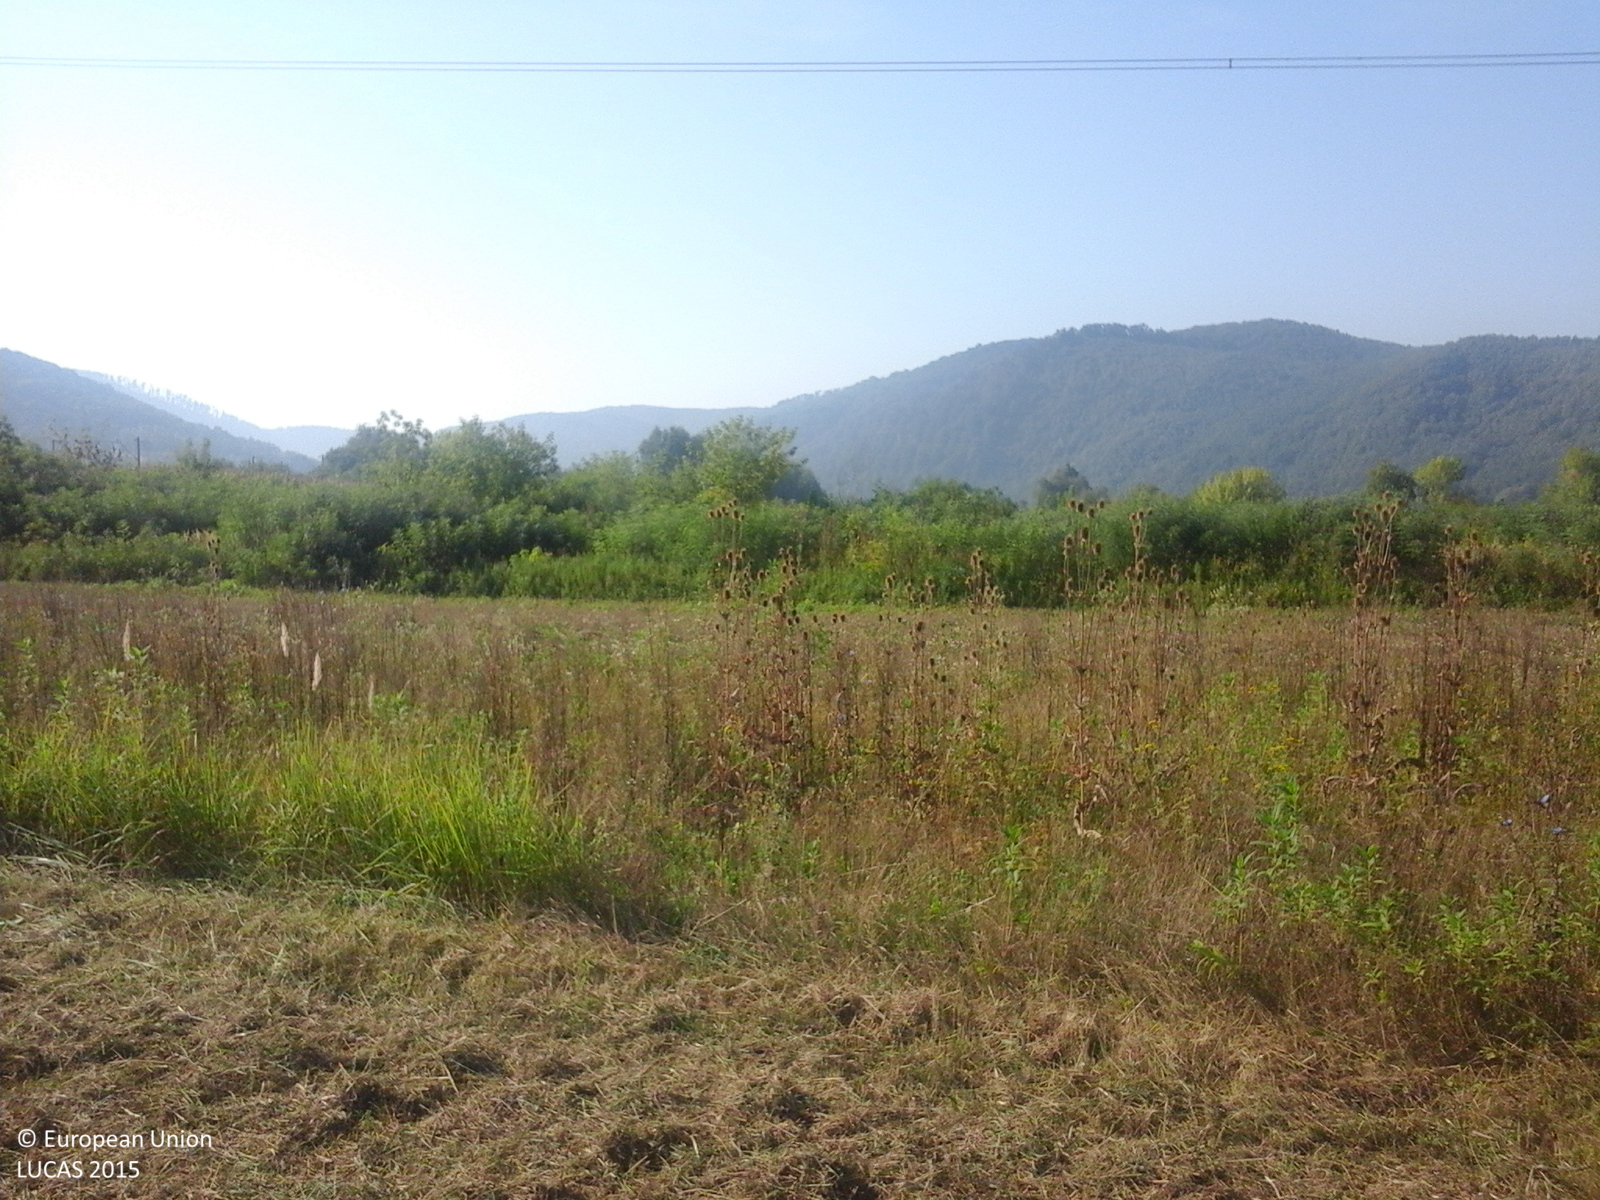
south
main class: Grassland
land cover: Grassland without tree/shrub cover
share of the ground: > 75 %
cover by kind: herbaceous plants 100 %
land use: Agriculture (excluding fallow land and kitchen gardens)
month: August
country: RO
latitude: 45.9875
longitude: 22.4276
